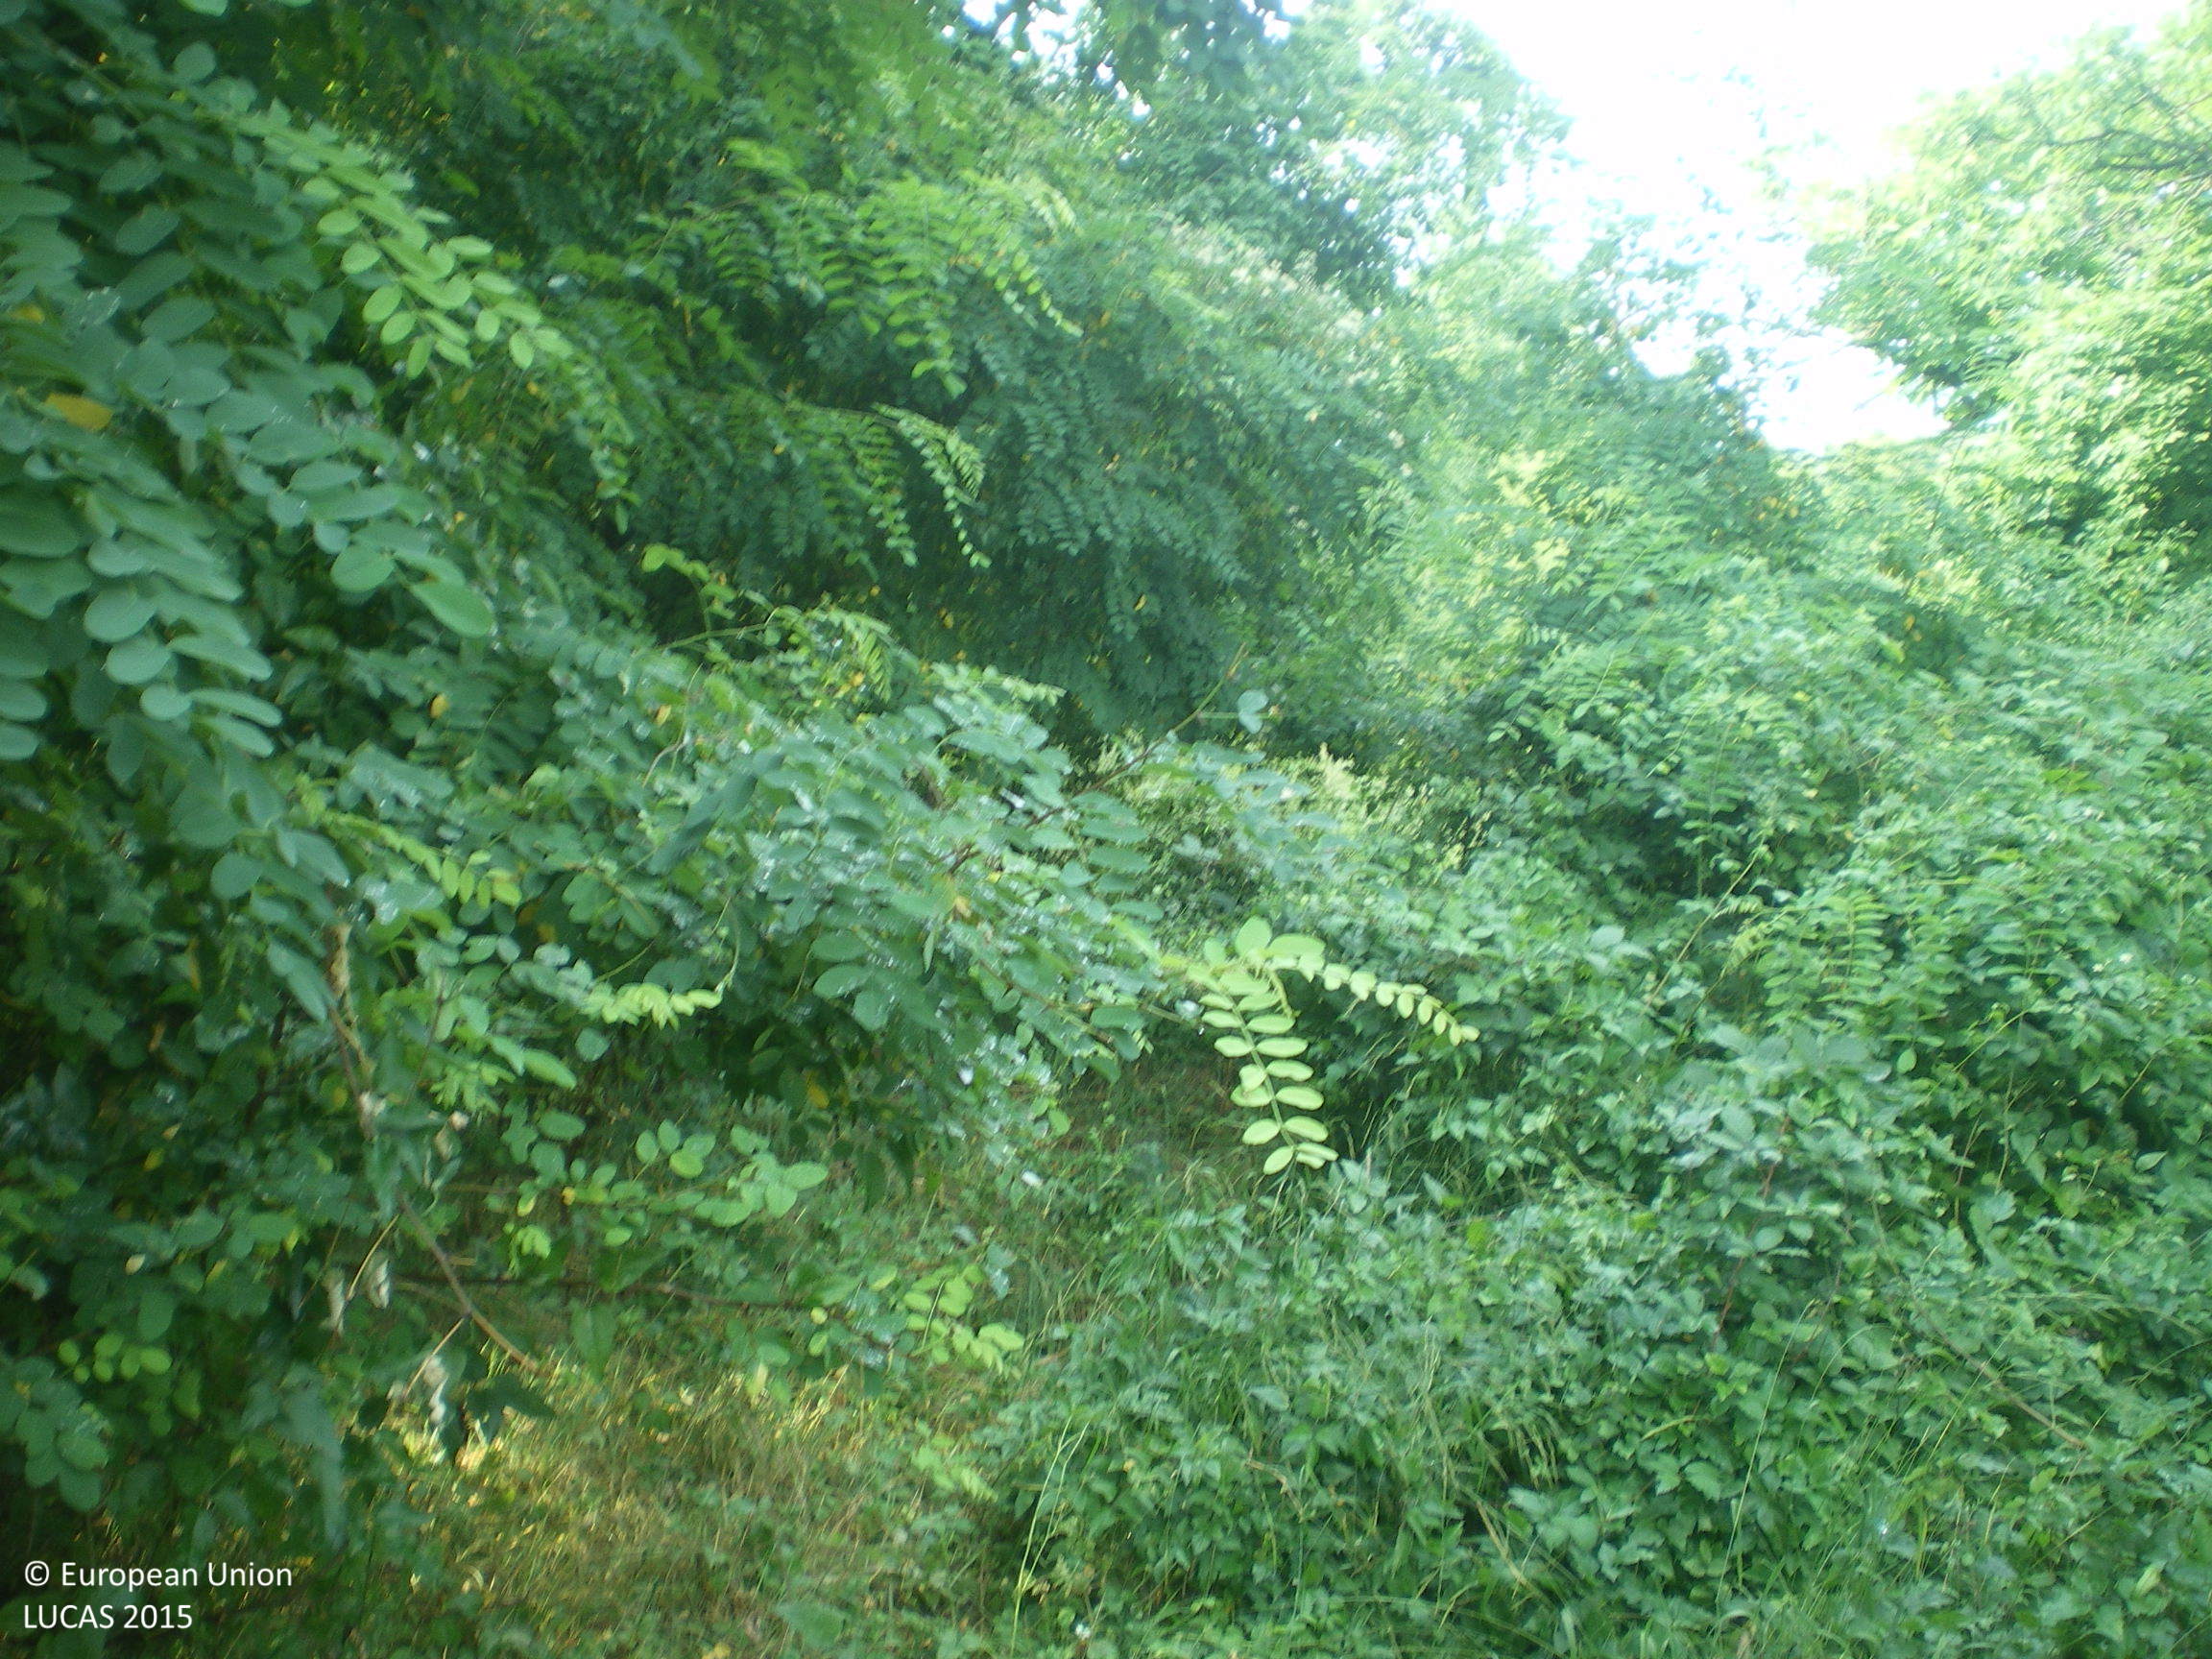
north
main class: Woodland
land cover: Broadleaved woodland
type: mesophytic deciduous forest
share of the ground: 50 - 75 %
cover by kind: broadleaved forest trees 50 %, herbaceous plants 30 %, shrubs 20 %
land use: Semi-natural and natural areas not in use
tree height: > 5 m
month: July
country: BG
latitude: 42.3888
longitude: 25.2599
